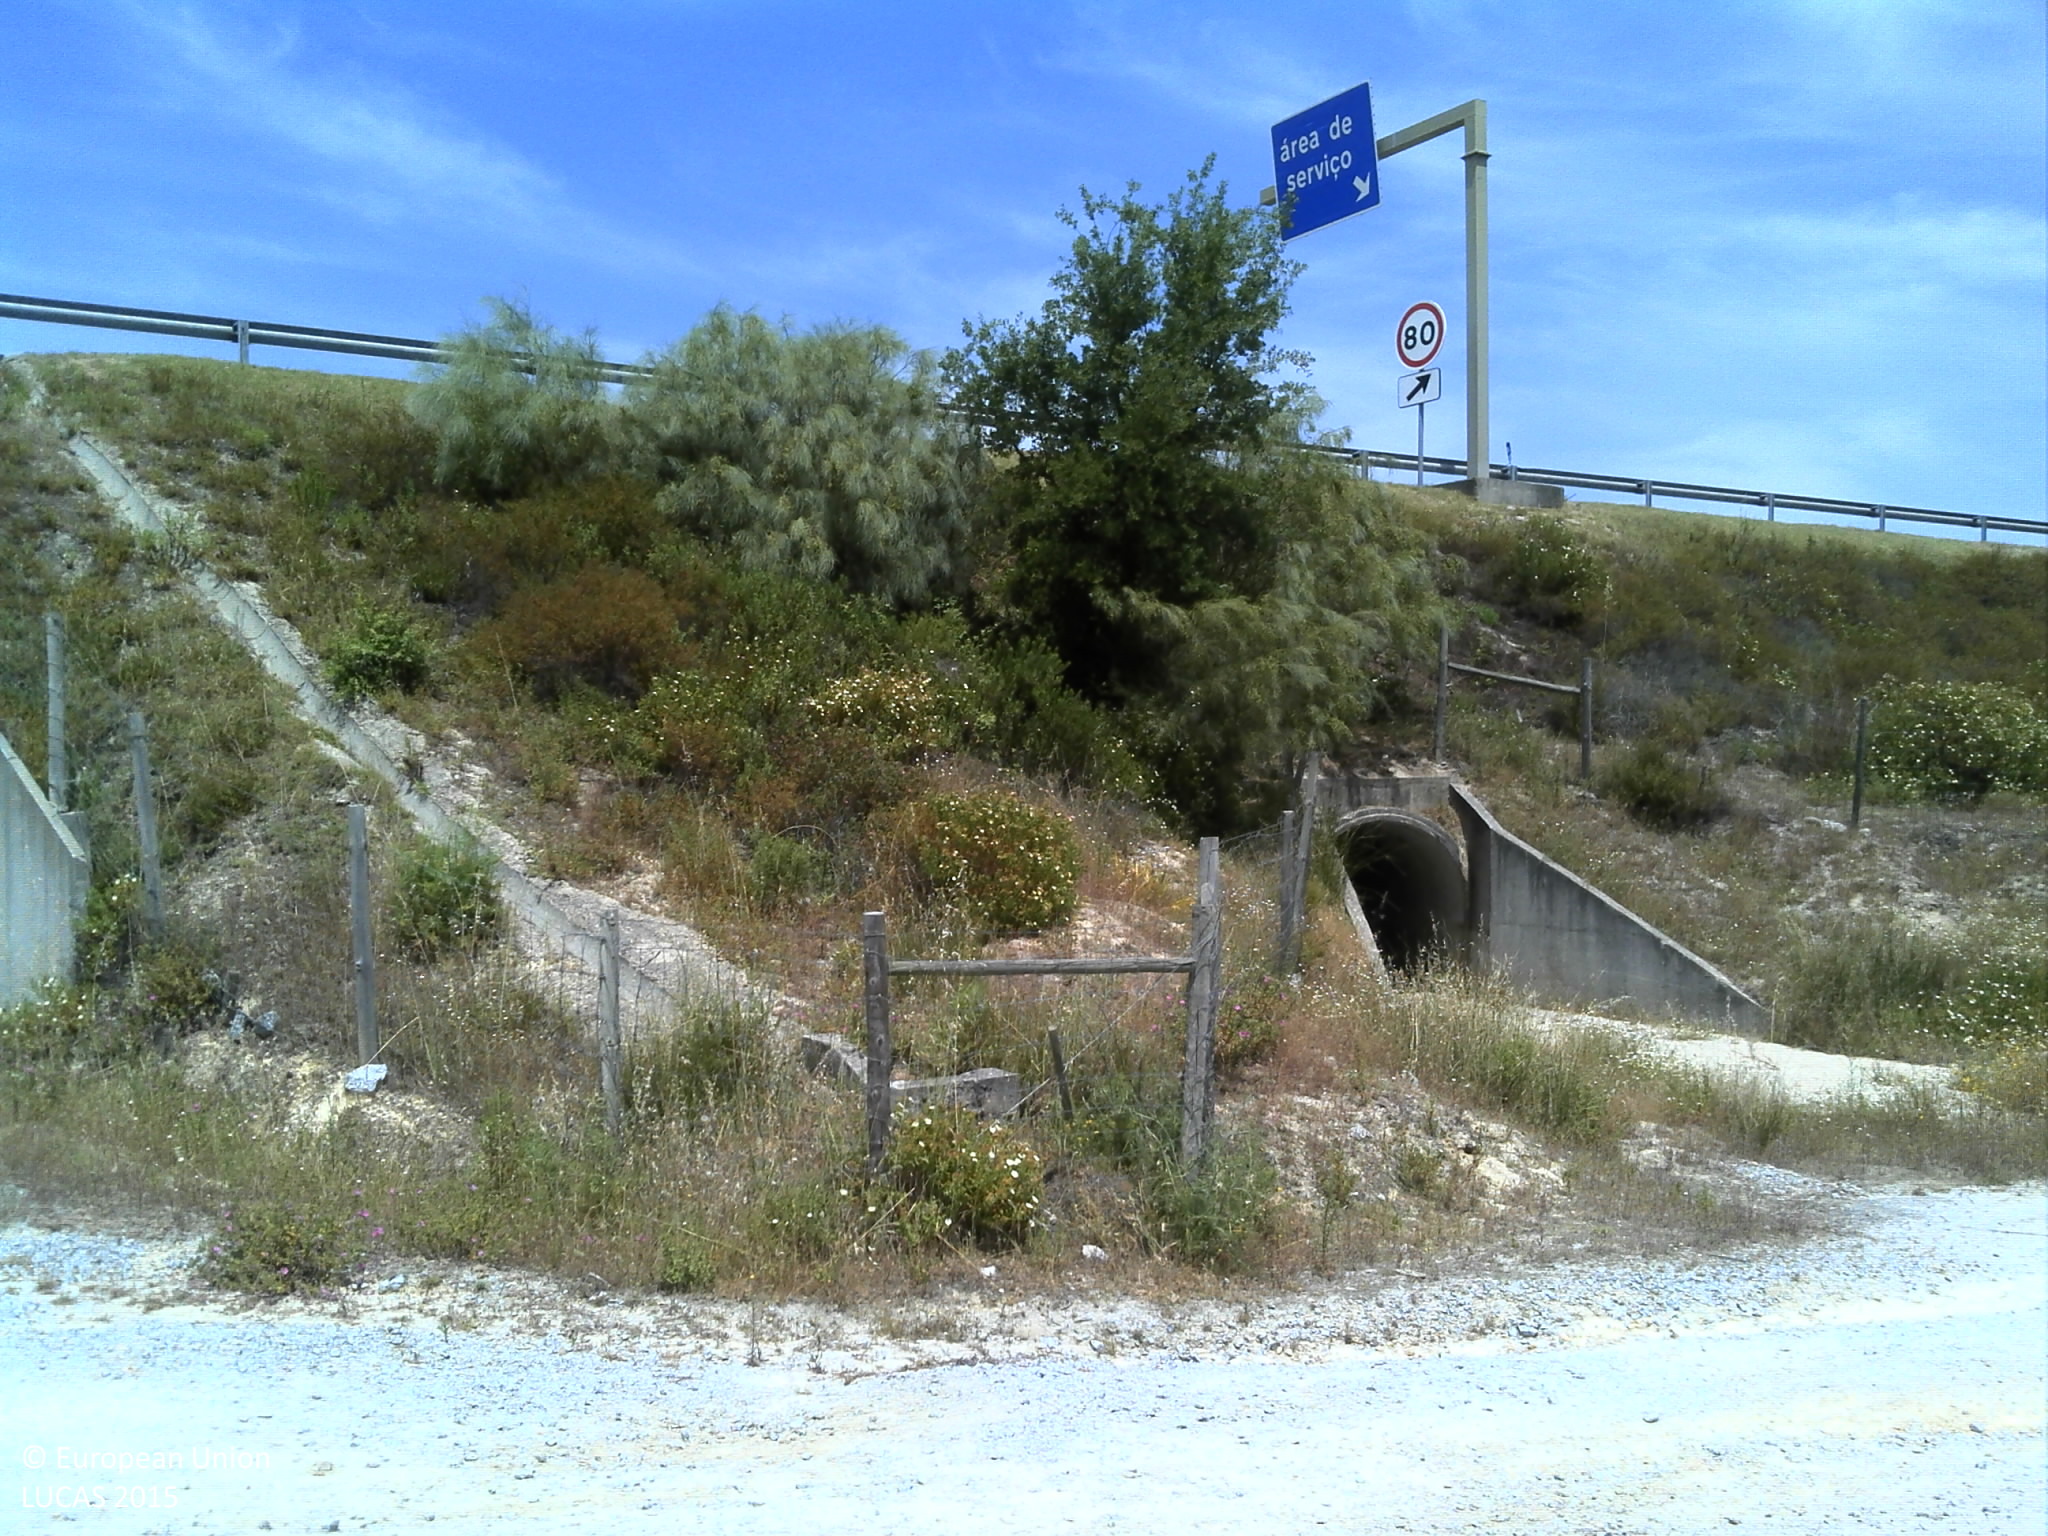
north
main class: Woodland
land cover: Pine dominated mixed woodland
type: coniferous forest of the mediterranean region
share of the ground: 10 - 25 %
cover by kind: herbaceous plants 40 %, coniferous forest trees 30 %, broadleaved forest trees 25 %, unconsolidated bare surface 5 %
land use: Forestry
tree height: > 5 m
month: May
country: PT
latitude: 38.6045
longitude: -8.5793
